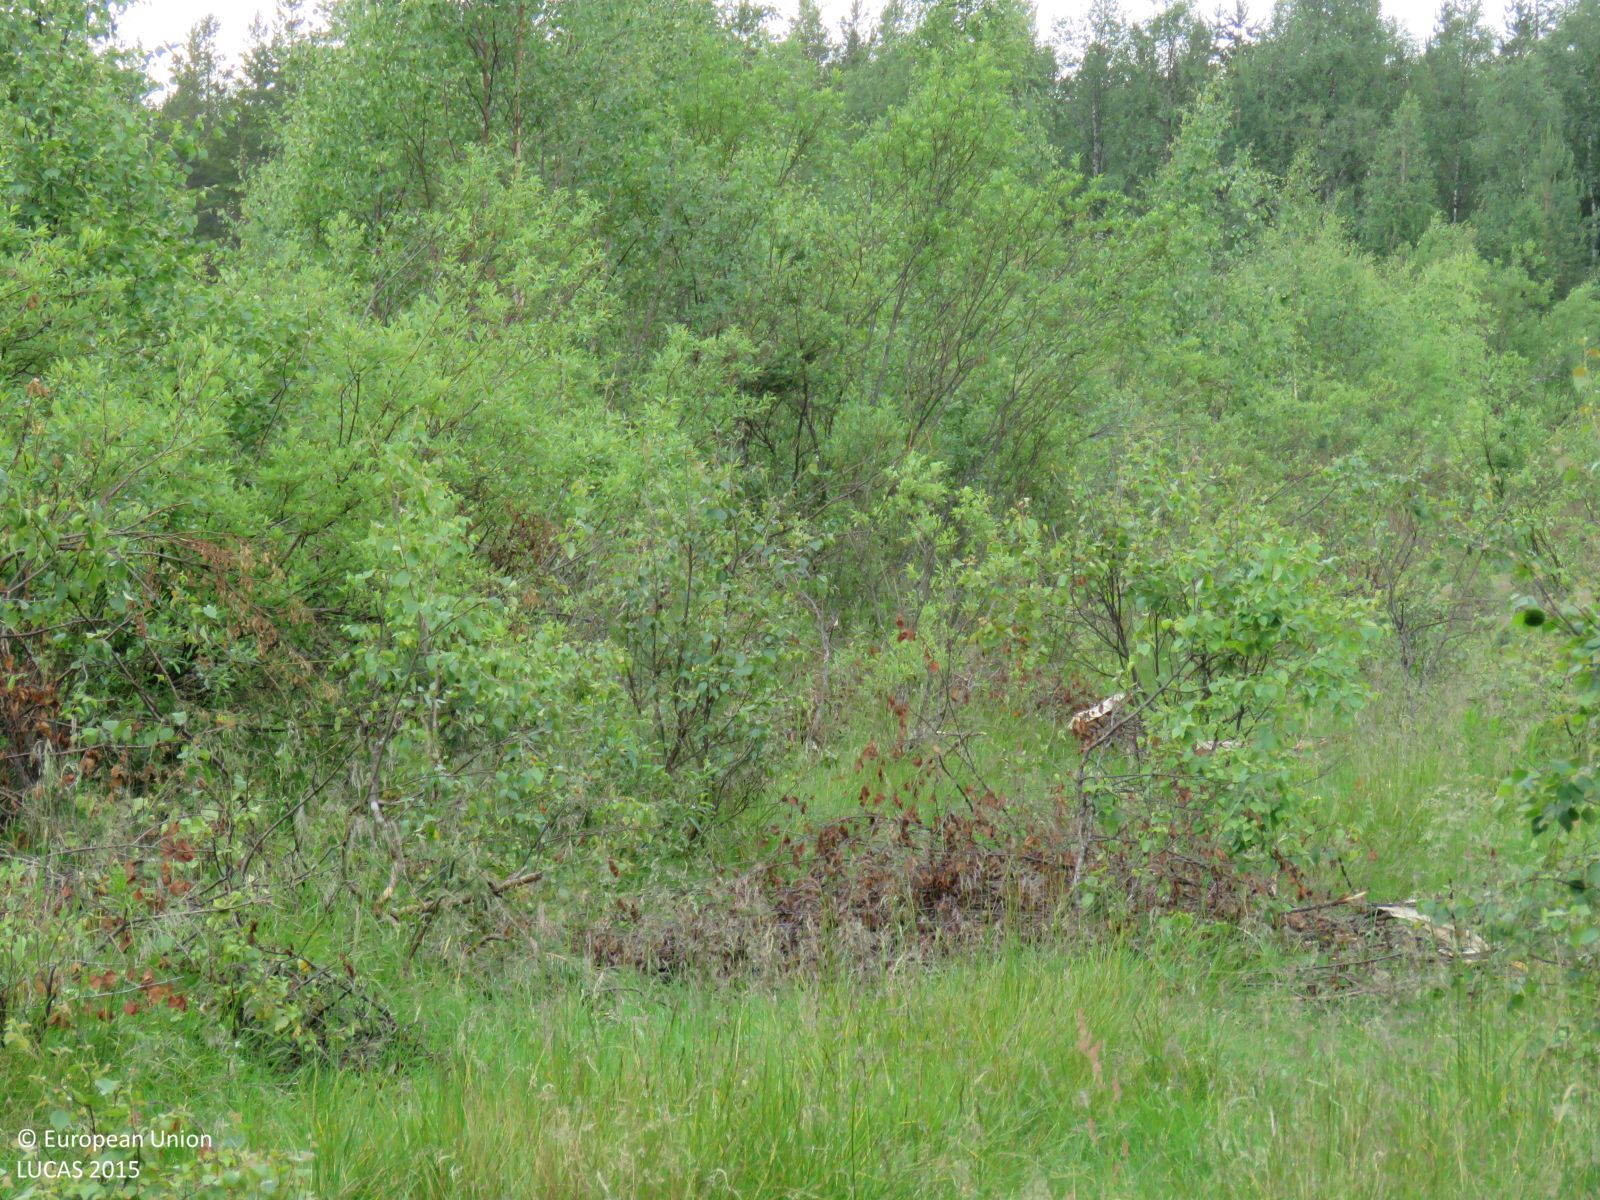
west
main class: Shrubland
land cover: Shrubland with sparse tree cover
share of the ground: 50 - 75 %
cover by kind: herbaceous plants 55 %, shrubs 40 %, broadleaved forest trees 5 %
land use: Semi-natural and natural areas not in use
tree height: < 5 m
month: July
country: FI
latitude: 64.4516
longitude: 26.6832
